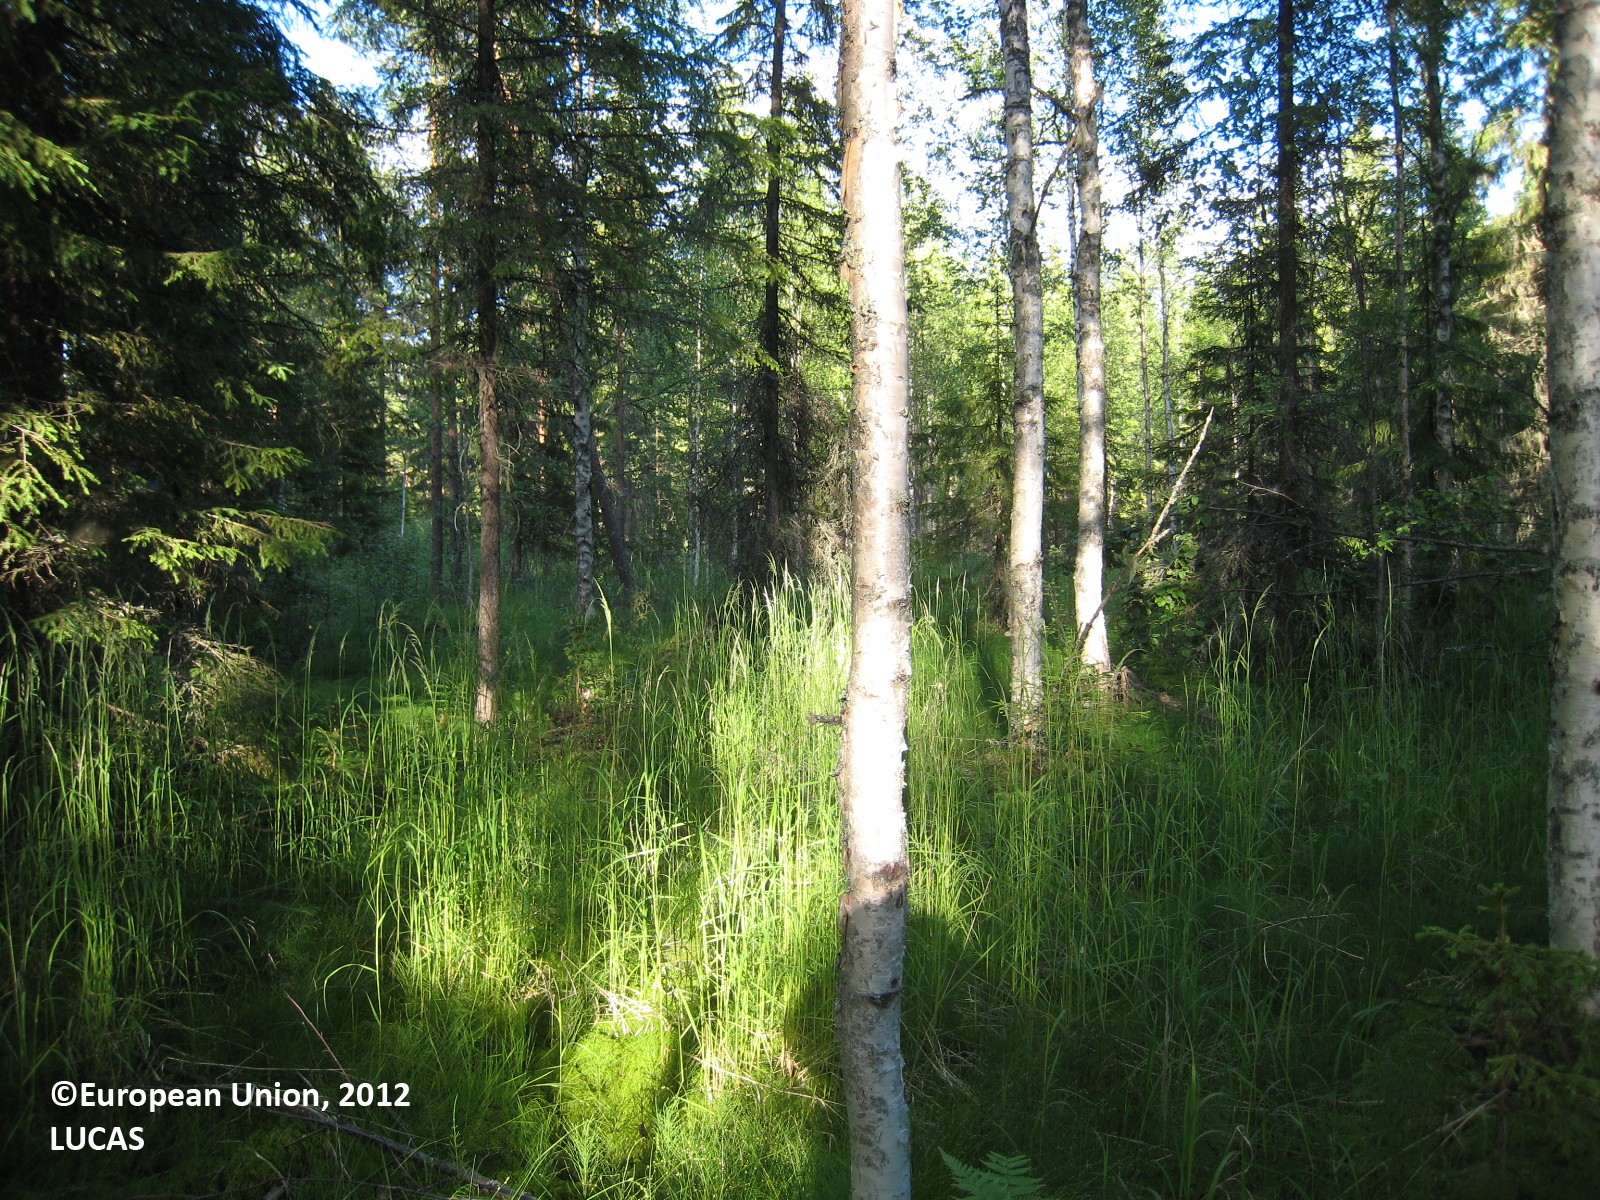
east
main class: Woodland
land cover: Spruce dominated mixed woodland
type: boreal forest
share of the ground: 50 - 75 %
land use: Forestry
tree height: > 5 m
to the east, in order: Spruce dominated mixed woodland; Other mixed woodland; Tracks; Other mixed woodland; Spruce dominated mixed woodland; Spruce dominated coniferous woodland
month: July
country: FI
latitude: 63.1486
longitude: 25.6876
